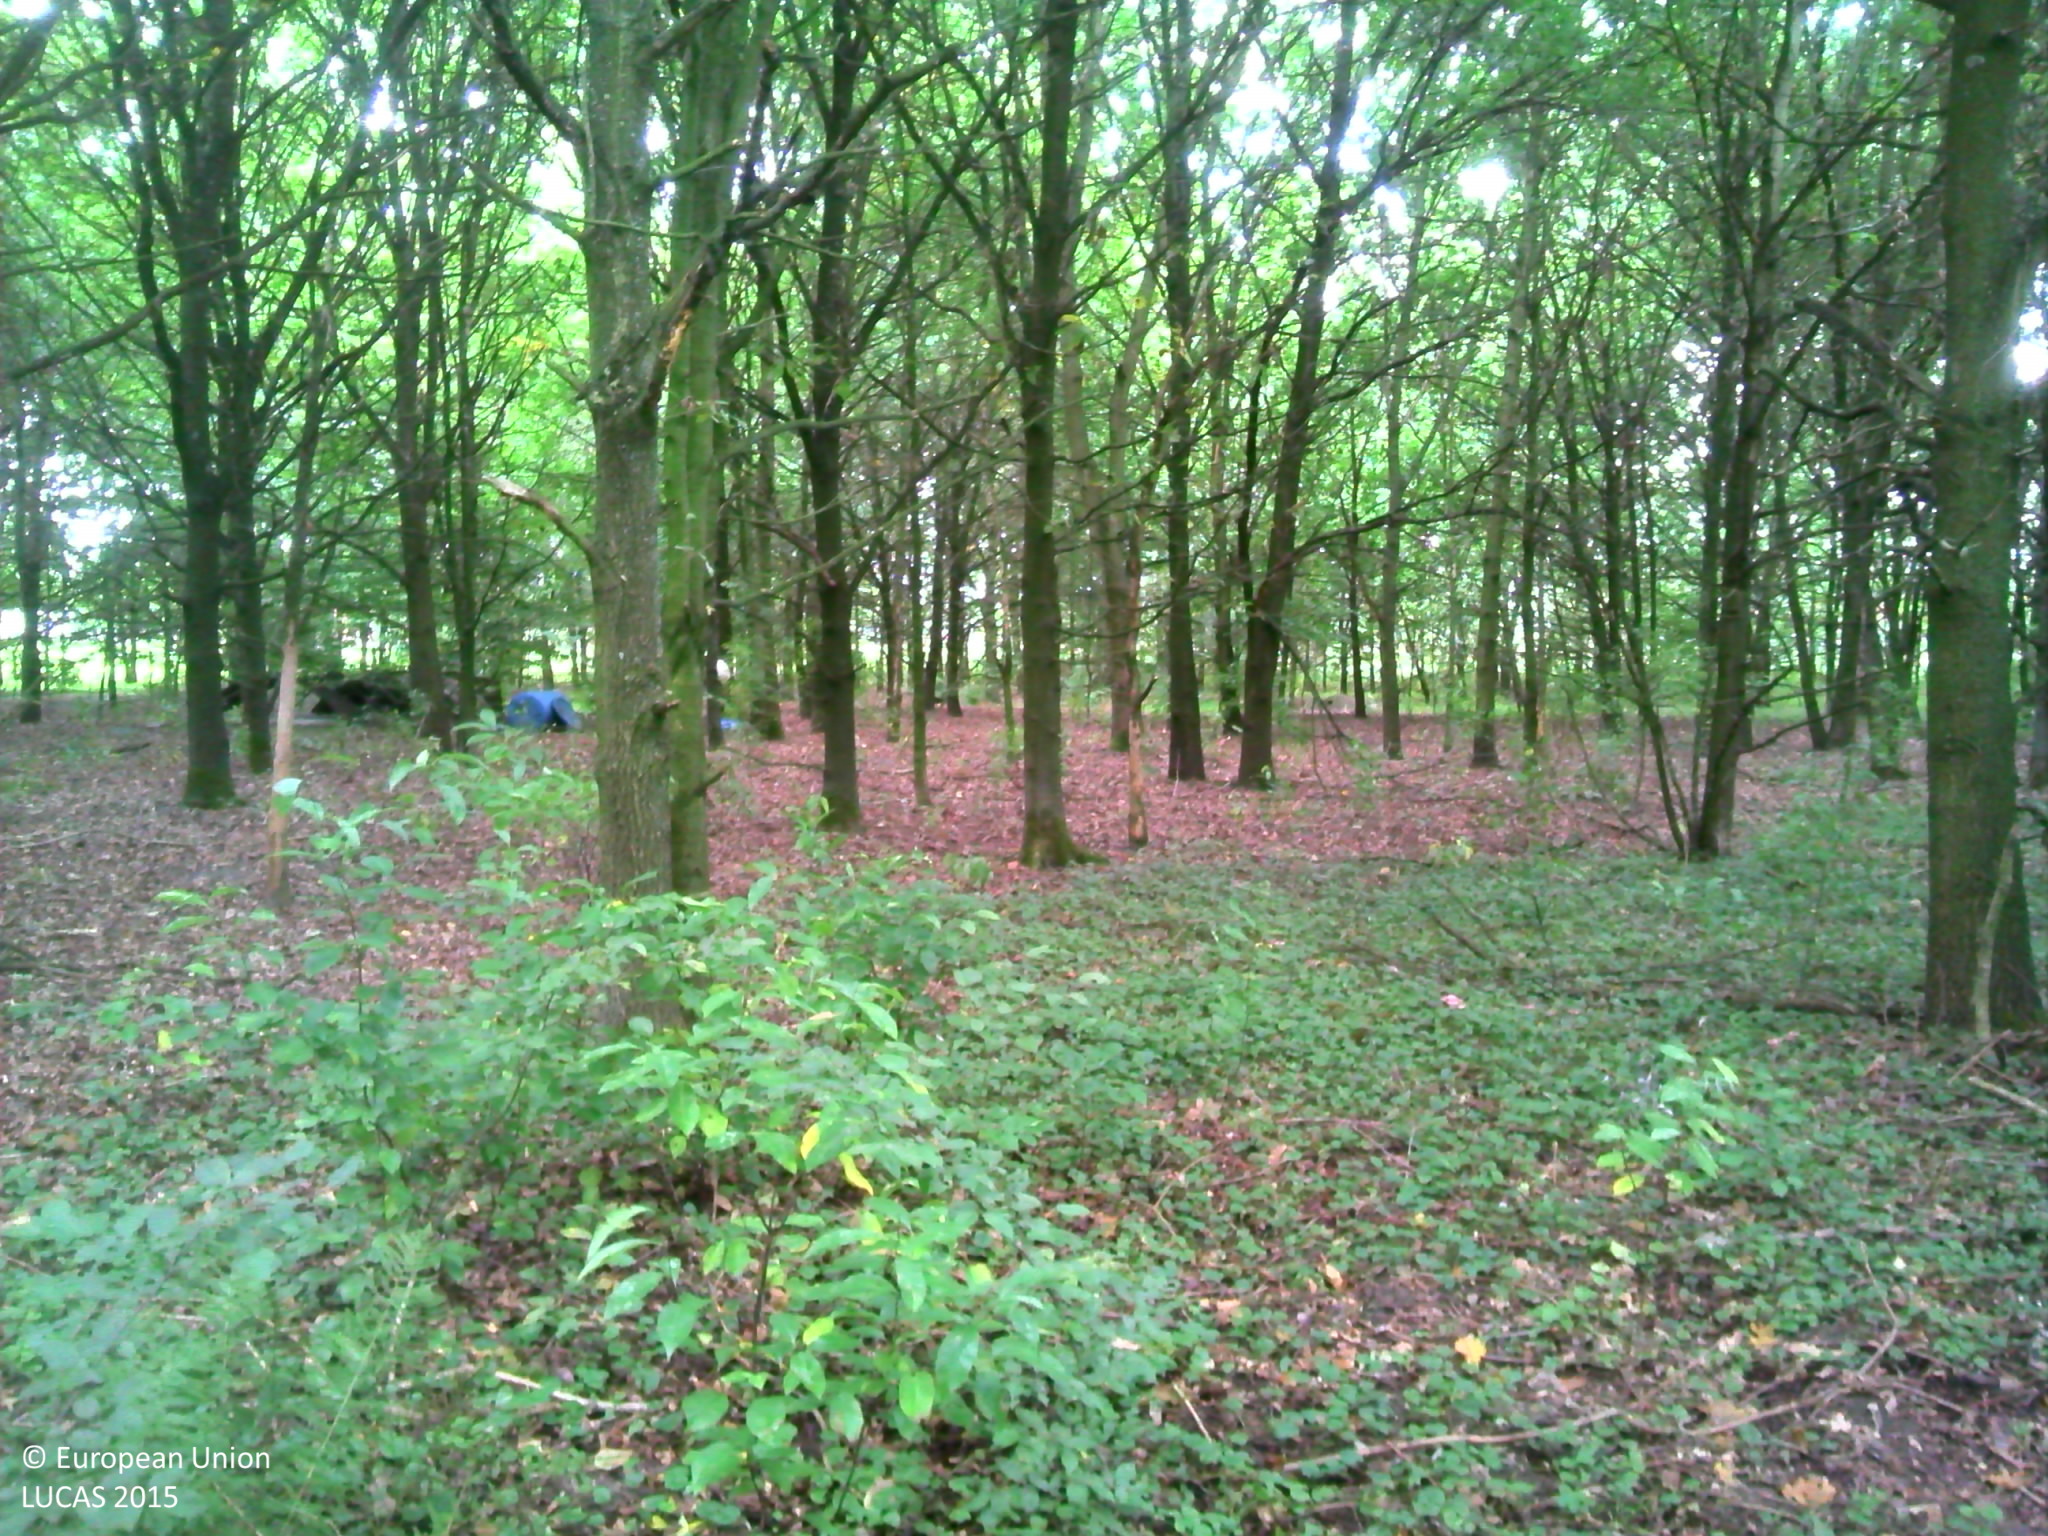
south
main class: Woodland
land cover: Broadleaved woodland
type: mesophytic deciduous forest
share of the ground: > 75 %
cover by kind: broadleaved forest trees 75 %, herbaceous plants 25 %
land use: Forestry
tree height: > 5 m
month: September
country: BE
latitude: 51.0330
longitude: 4.6773
